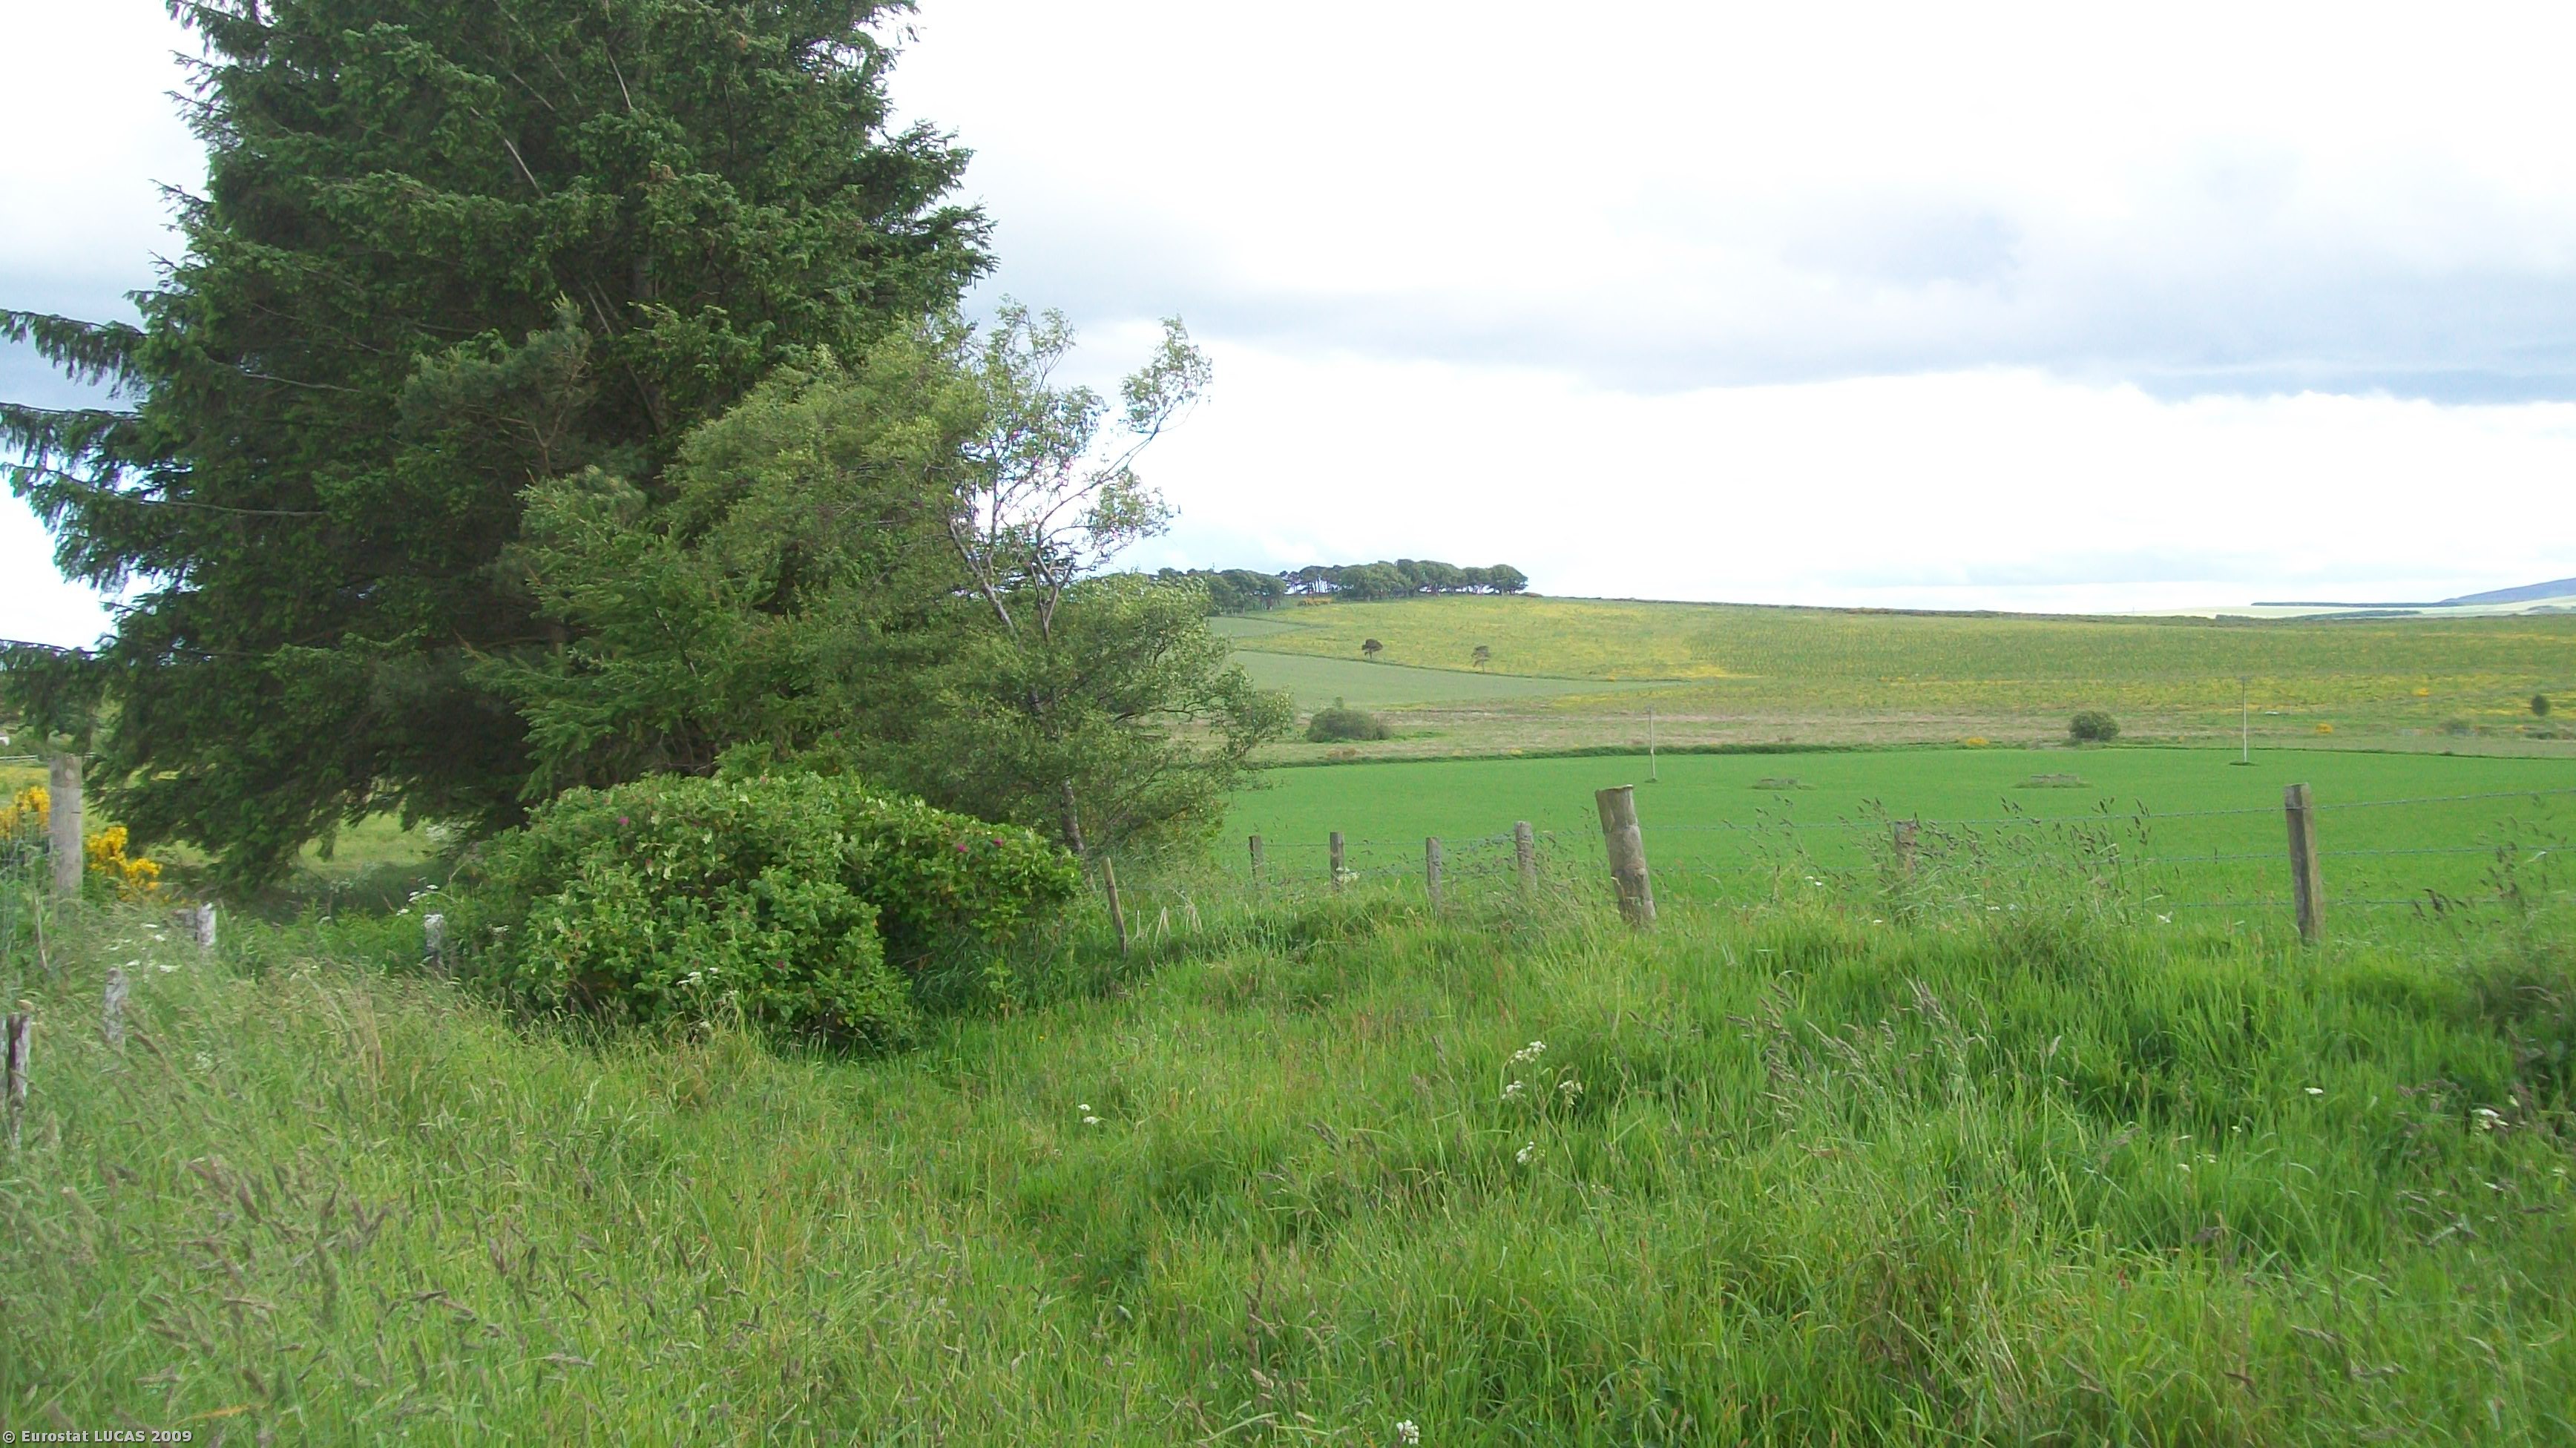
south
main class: Woodland
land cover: Mixed woodland
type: plantations and self-sown exotic forest
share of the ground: > 75 %
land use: Unused
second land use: Nature reserves
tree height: > 5 m
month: June
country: GB
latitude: 57.4796
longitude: -2.5792
